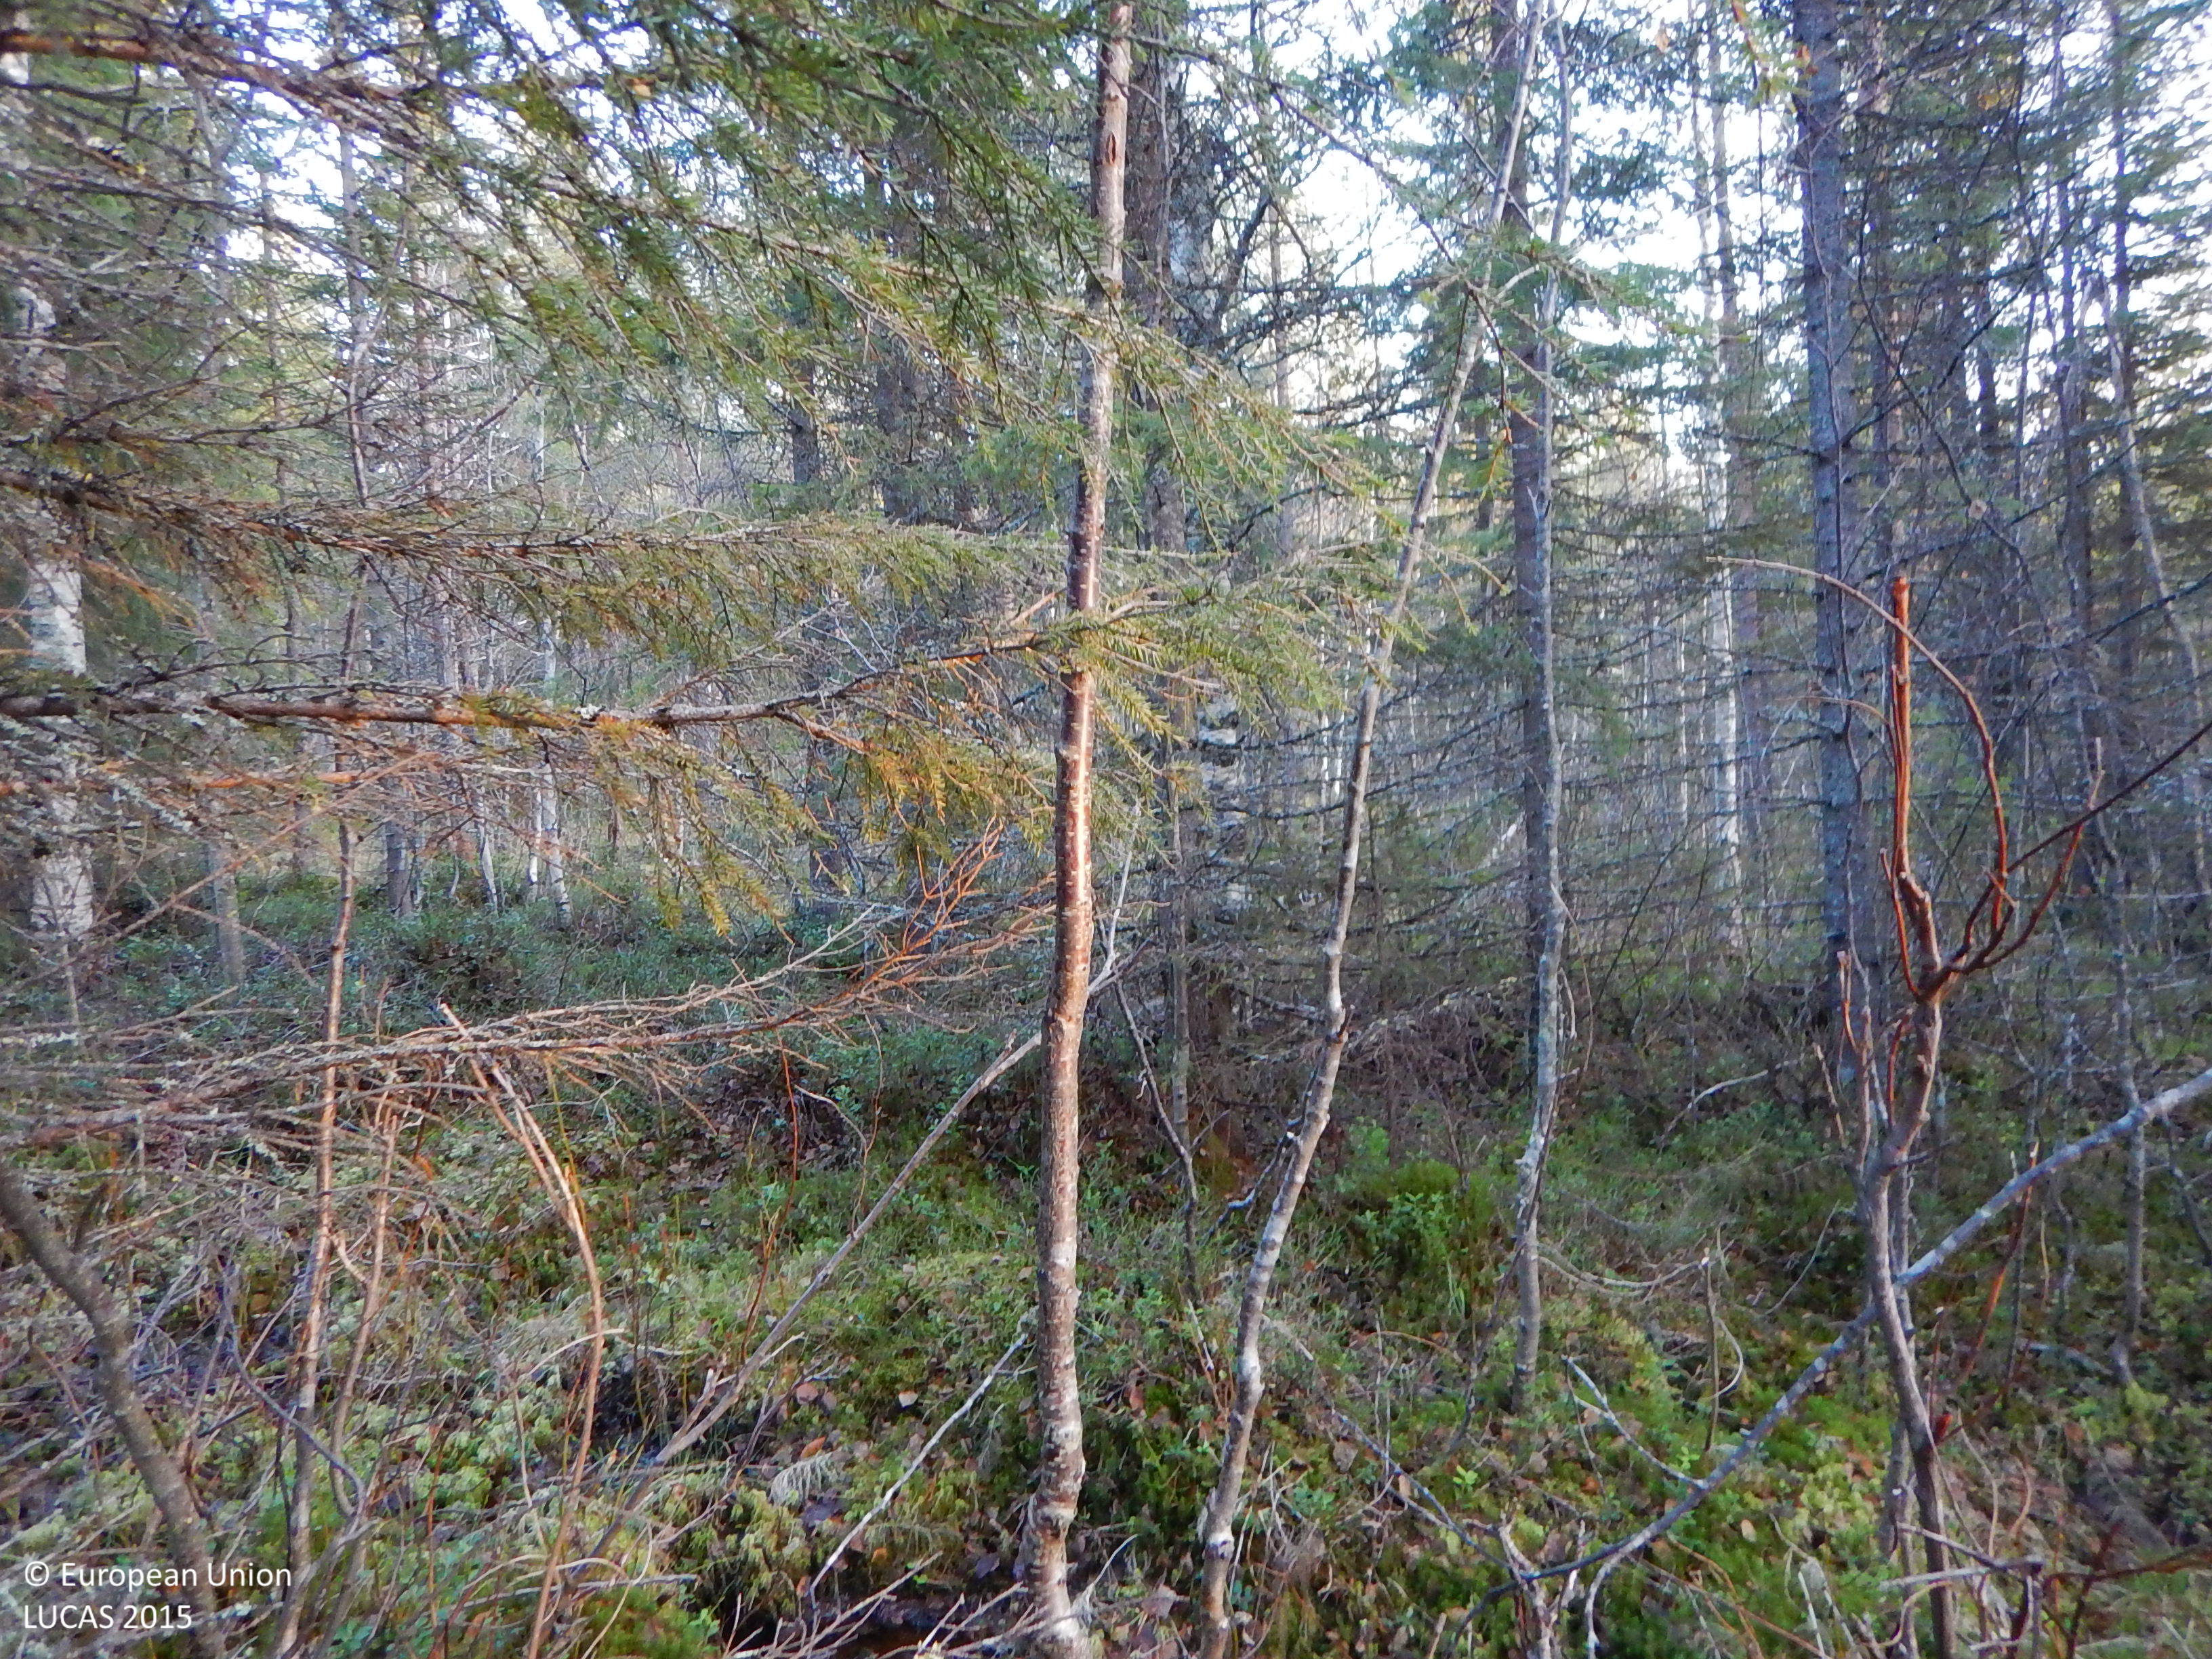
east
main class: Woodland
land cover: Spruce dominated mixed woodland
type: boreal forest
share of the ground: 50 - 75 %
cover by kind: coniferous forest trees 40 %, broadleaved forest trees 20 %, lichens and mosses 20 %, shrubs 10 %, herbaceous plants 10 %
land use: Forestry
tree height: > 5 m
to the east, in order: Spruce dominated mixed woodland; Pine dominated coniferous woodland; Other mixed woodland; Ditches and canals; Paved roads, cycling and walking lanes; Grass margins; Ditches and canals; Pine dominated coniferous woodland; Broadleaved woodland
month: November
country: SE
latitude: 65.2320
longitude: 20.5594
